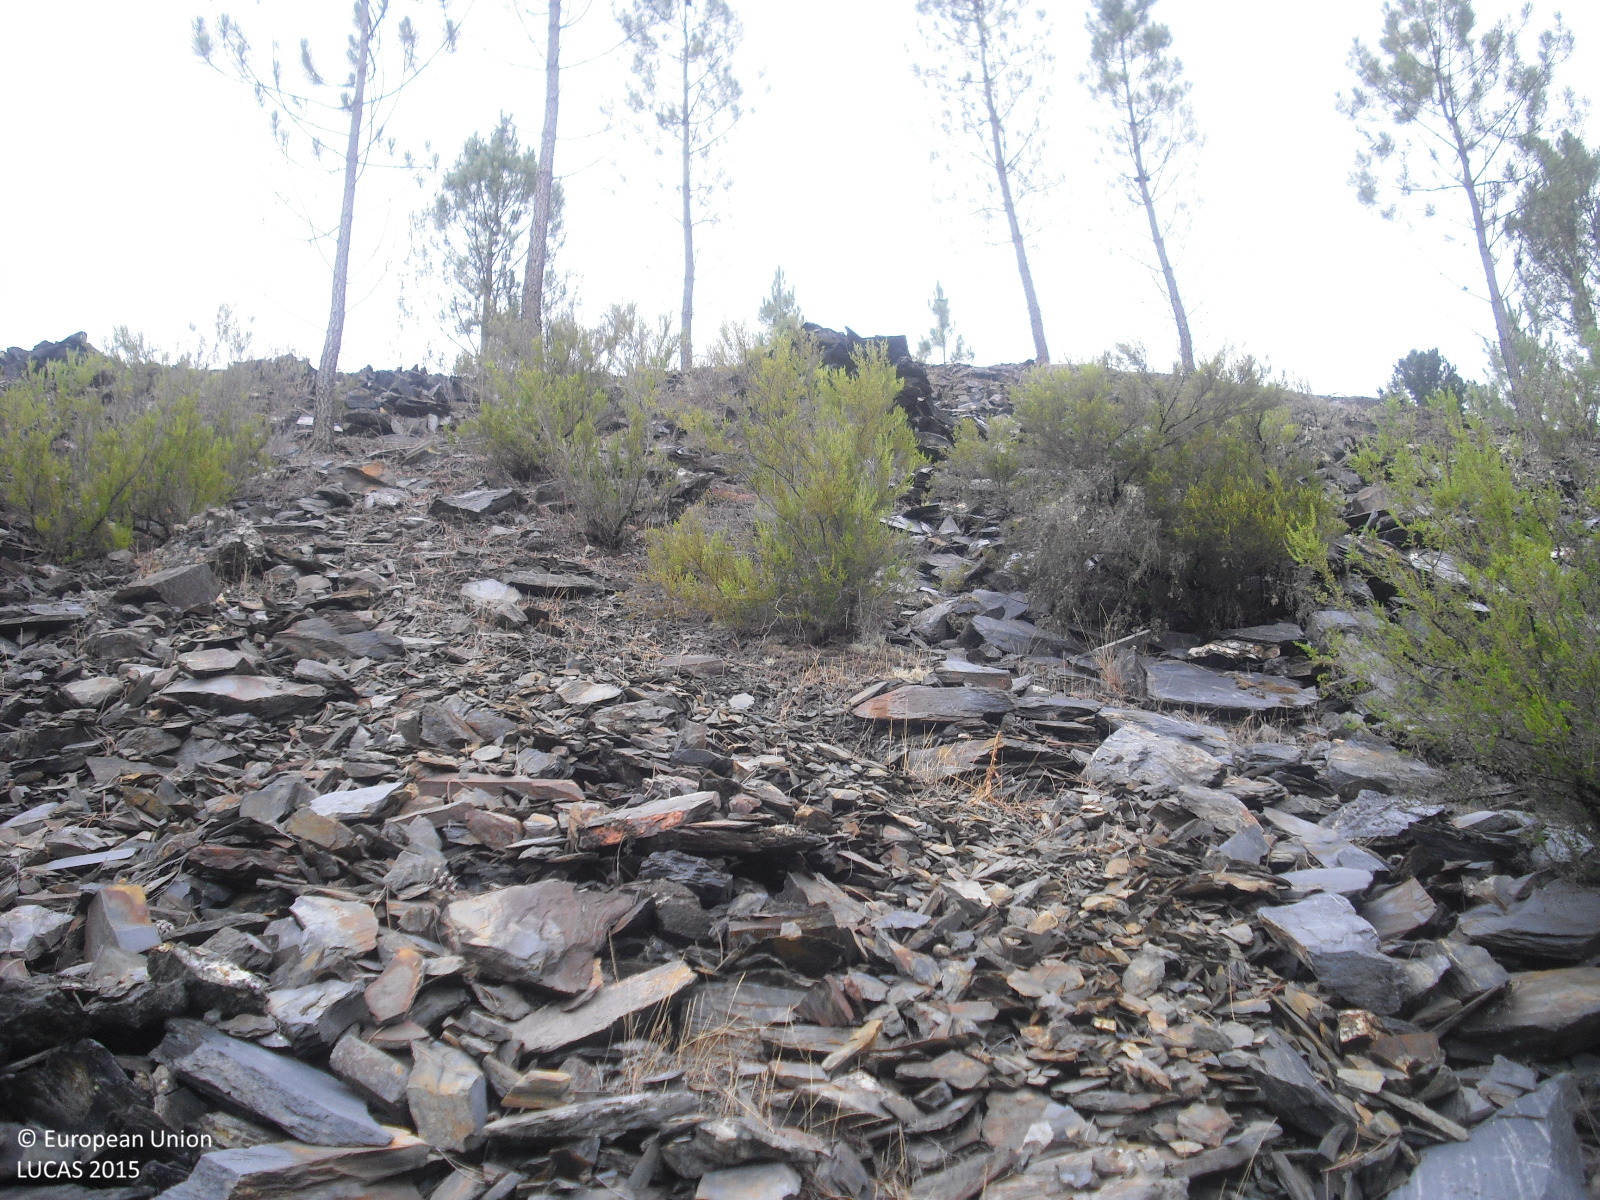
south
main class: Woodland
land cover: Broadleaved woodland
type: floodplain forest
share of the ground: 50 - 75 %
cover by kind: broadleaved forest trees 60 %, consolidated bare surface 30 %, shrubs 10 %
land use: Semi-natural and natural areas not in use
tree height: > 5 m
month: July
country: ES
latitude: 42.3858
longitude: -7.1982
